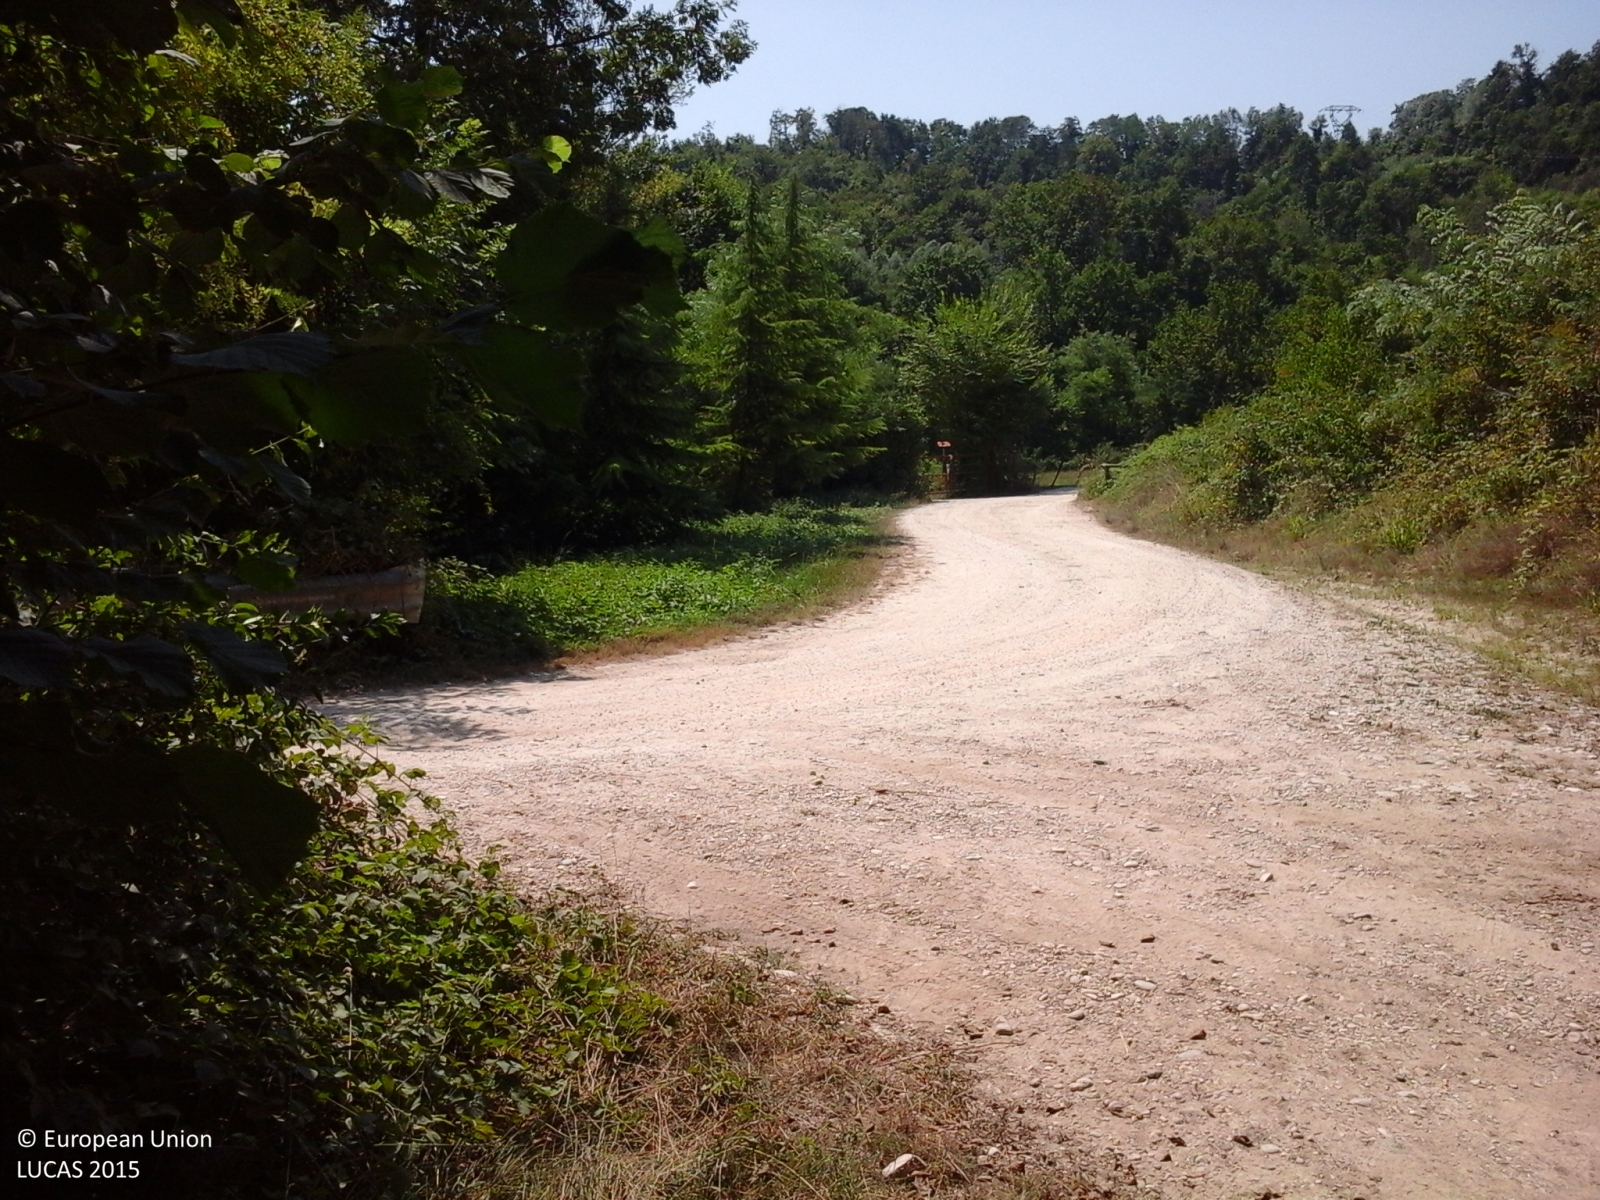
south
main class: Woodland
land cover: Broadleaved woodland
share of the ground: > 75 %
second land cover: Grassland without tree/shrub cover
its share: > 75 %
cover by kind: broadleaved forest trees 90 %, herbaceous plants 10 %
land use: Forestry
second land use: Agriculture (excluding fallow land and kitchen gardens)
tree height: > 5 m
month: July
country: IT
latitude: 45.8595
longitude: 12.2251
